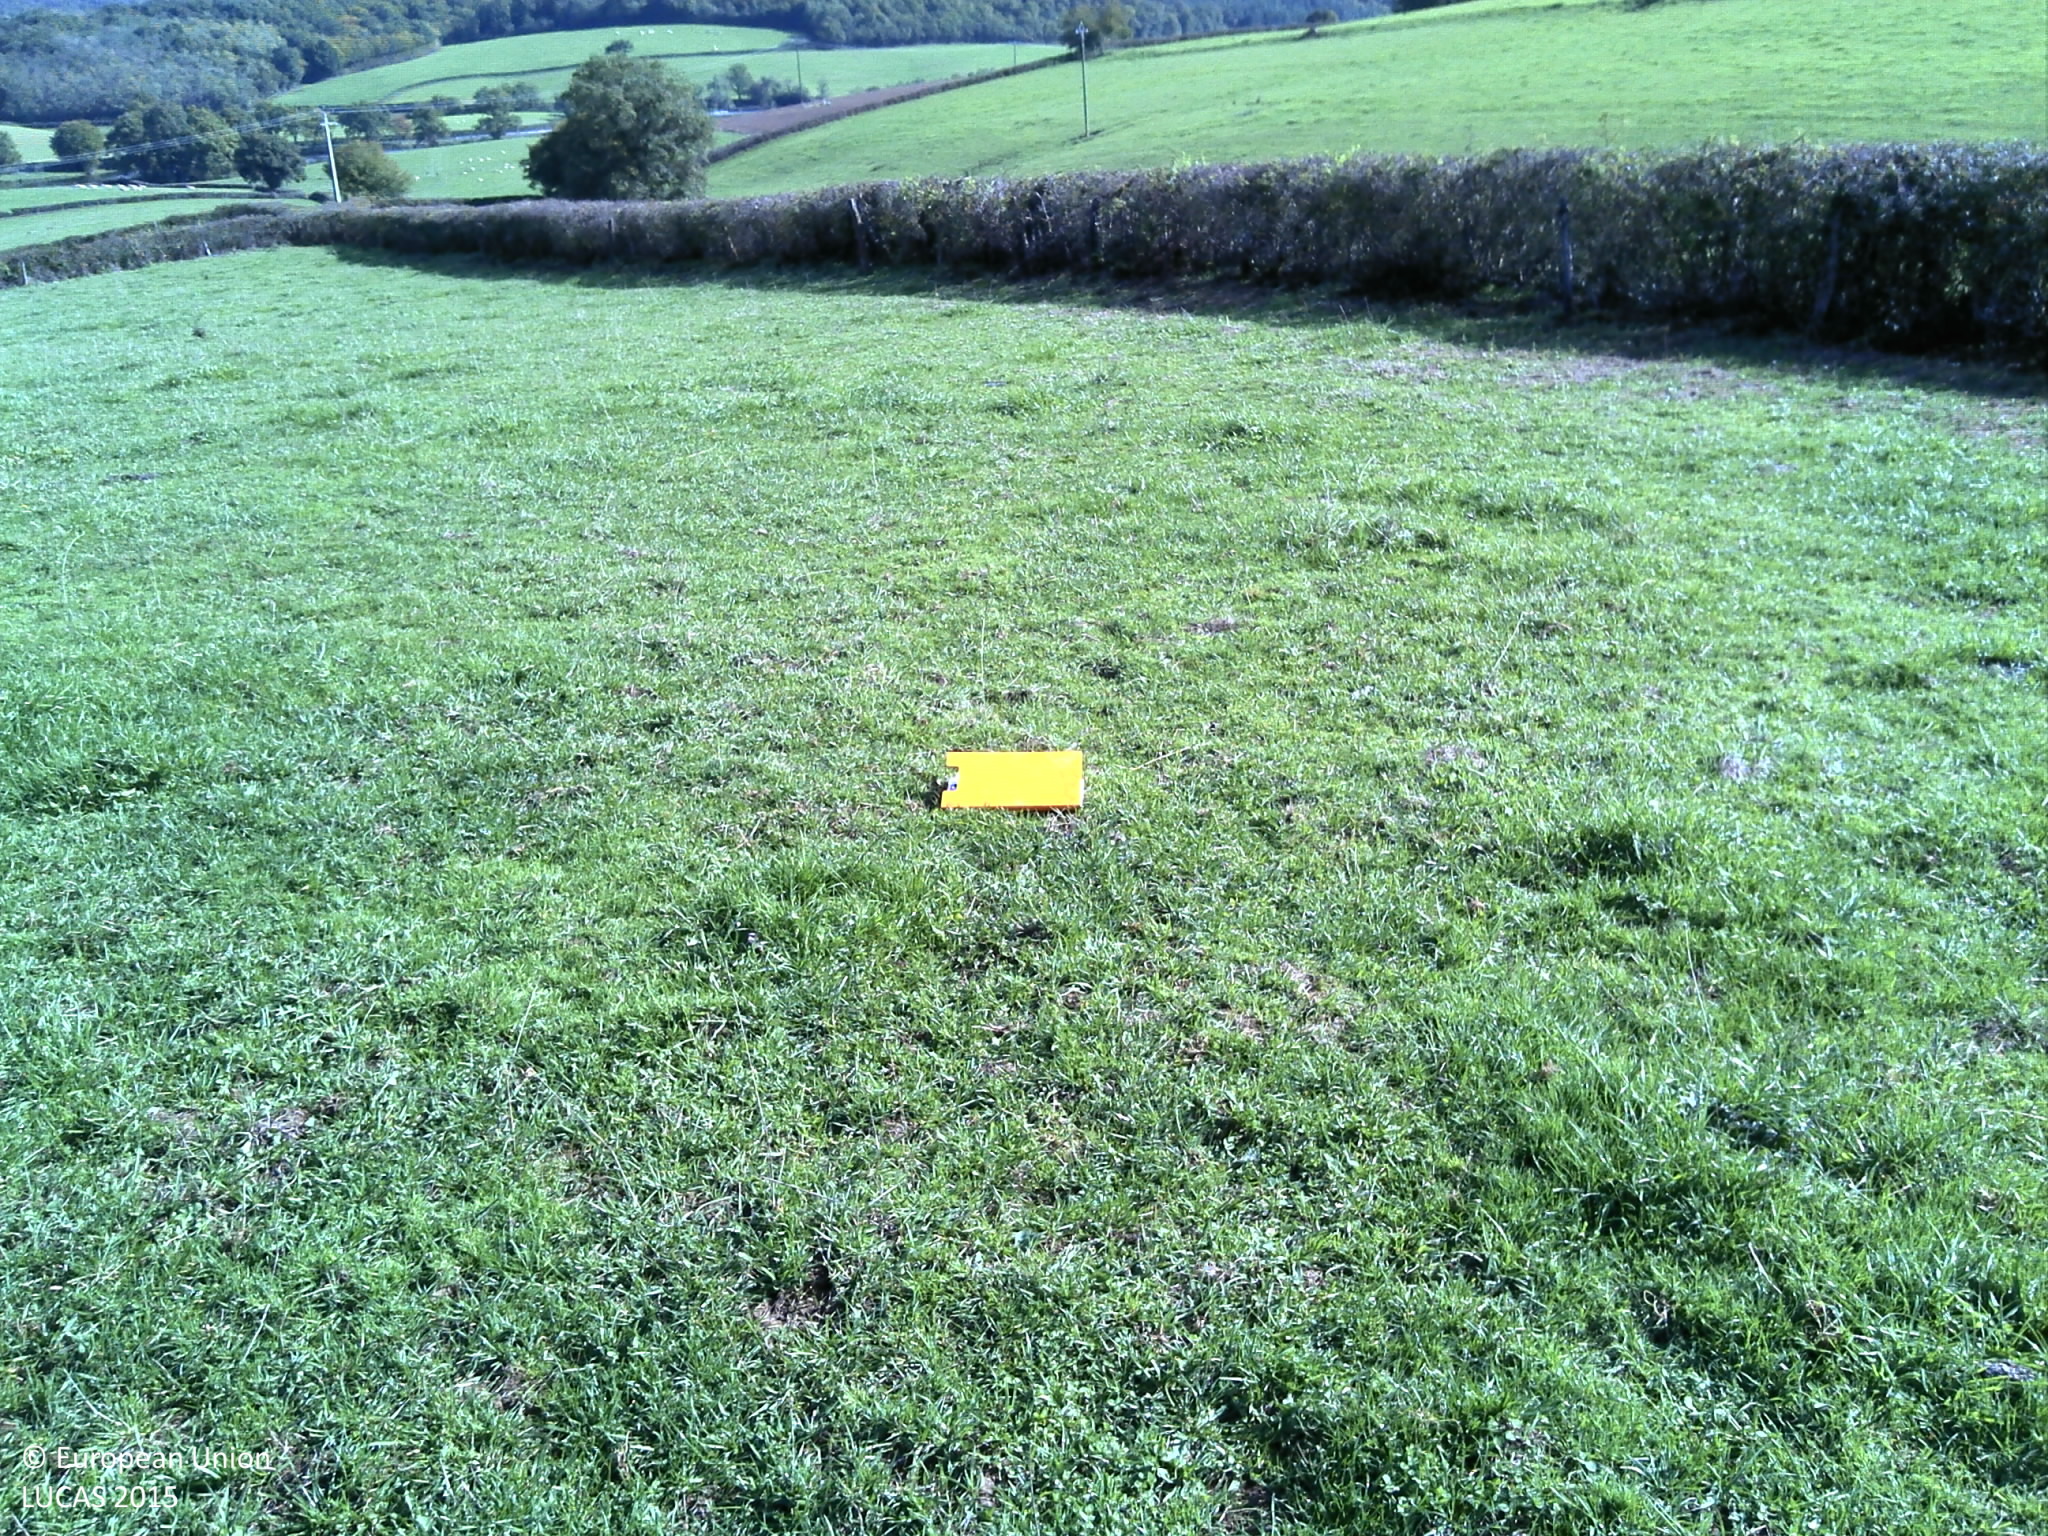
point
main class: Grassland
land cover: Grassland without tree/shrub cover
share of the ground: > 75 %
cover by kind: herbaceous plants 100 %
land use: Agriculture (excluding fallow land and kitchen gardens)
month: October
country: FR
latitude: 46.6553
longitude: 4.0543
